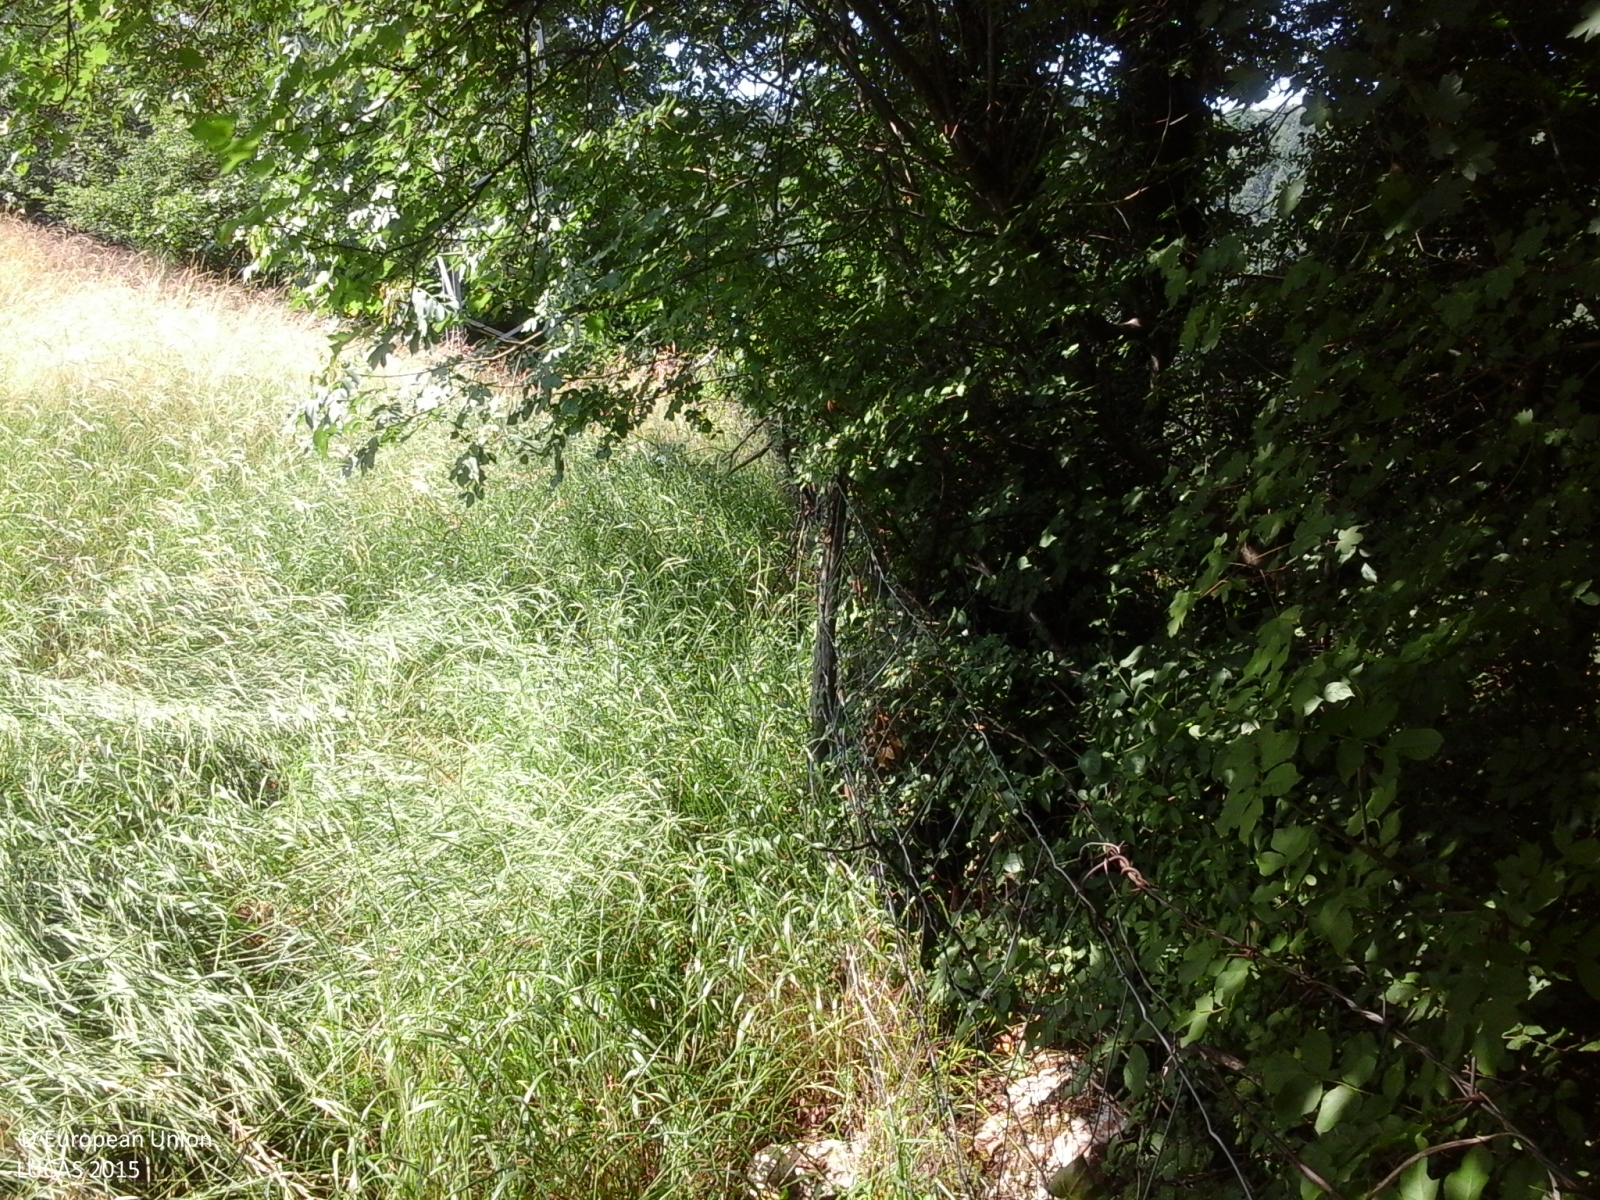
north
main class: Woodland
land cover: Broadleaved woodland
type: thermophilous deciduous forest
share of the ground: > 75 %
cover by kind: broadleaved forest trees 100 %
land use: Forestry
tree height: > 5 m
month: July
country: IT
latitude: 45.5523
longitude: 11.1382
